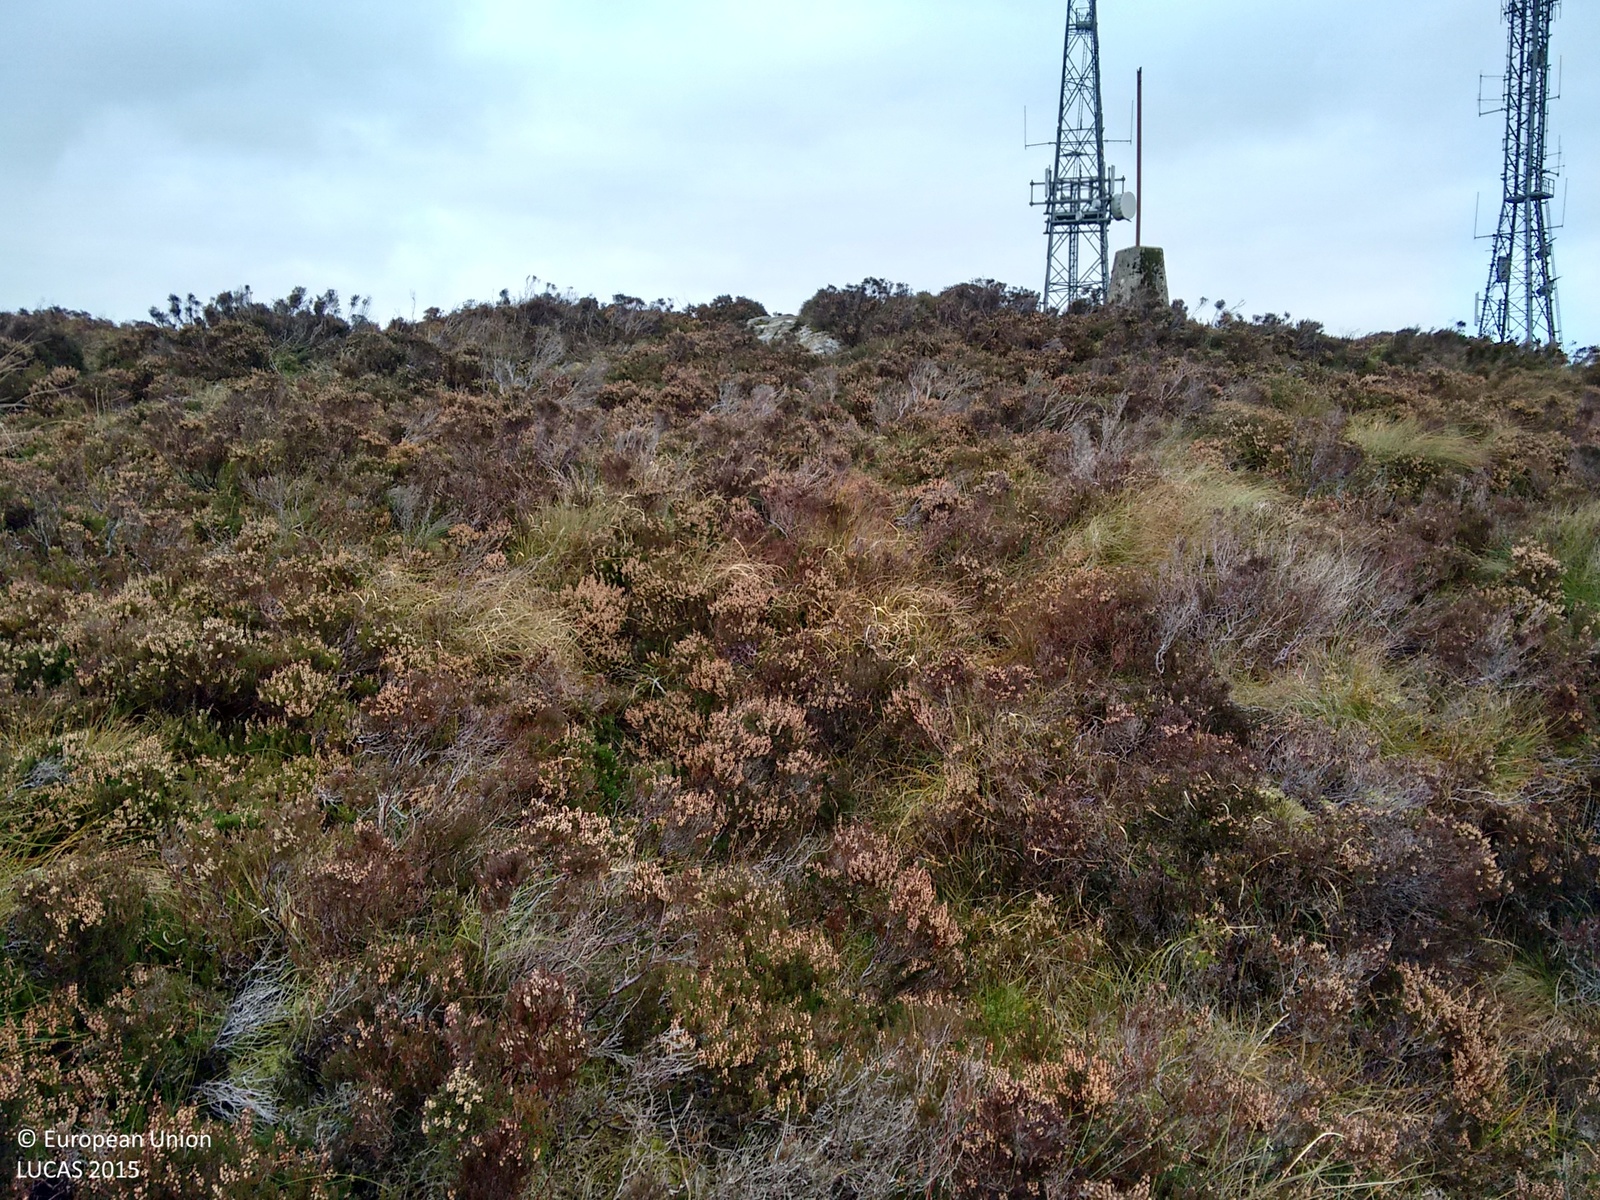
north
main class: Shrubland
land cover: Shrubland without tree cover
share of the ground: > 75 %
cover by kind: shrubs 80 %, lichens and mosses 20 %
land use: Agriculture (excluding fallow land and kitchen gardens)
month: October
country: GB
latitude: 54.4223
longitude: -7.4626
